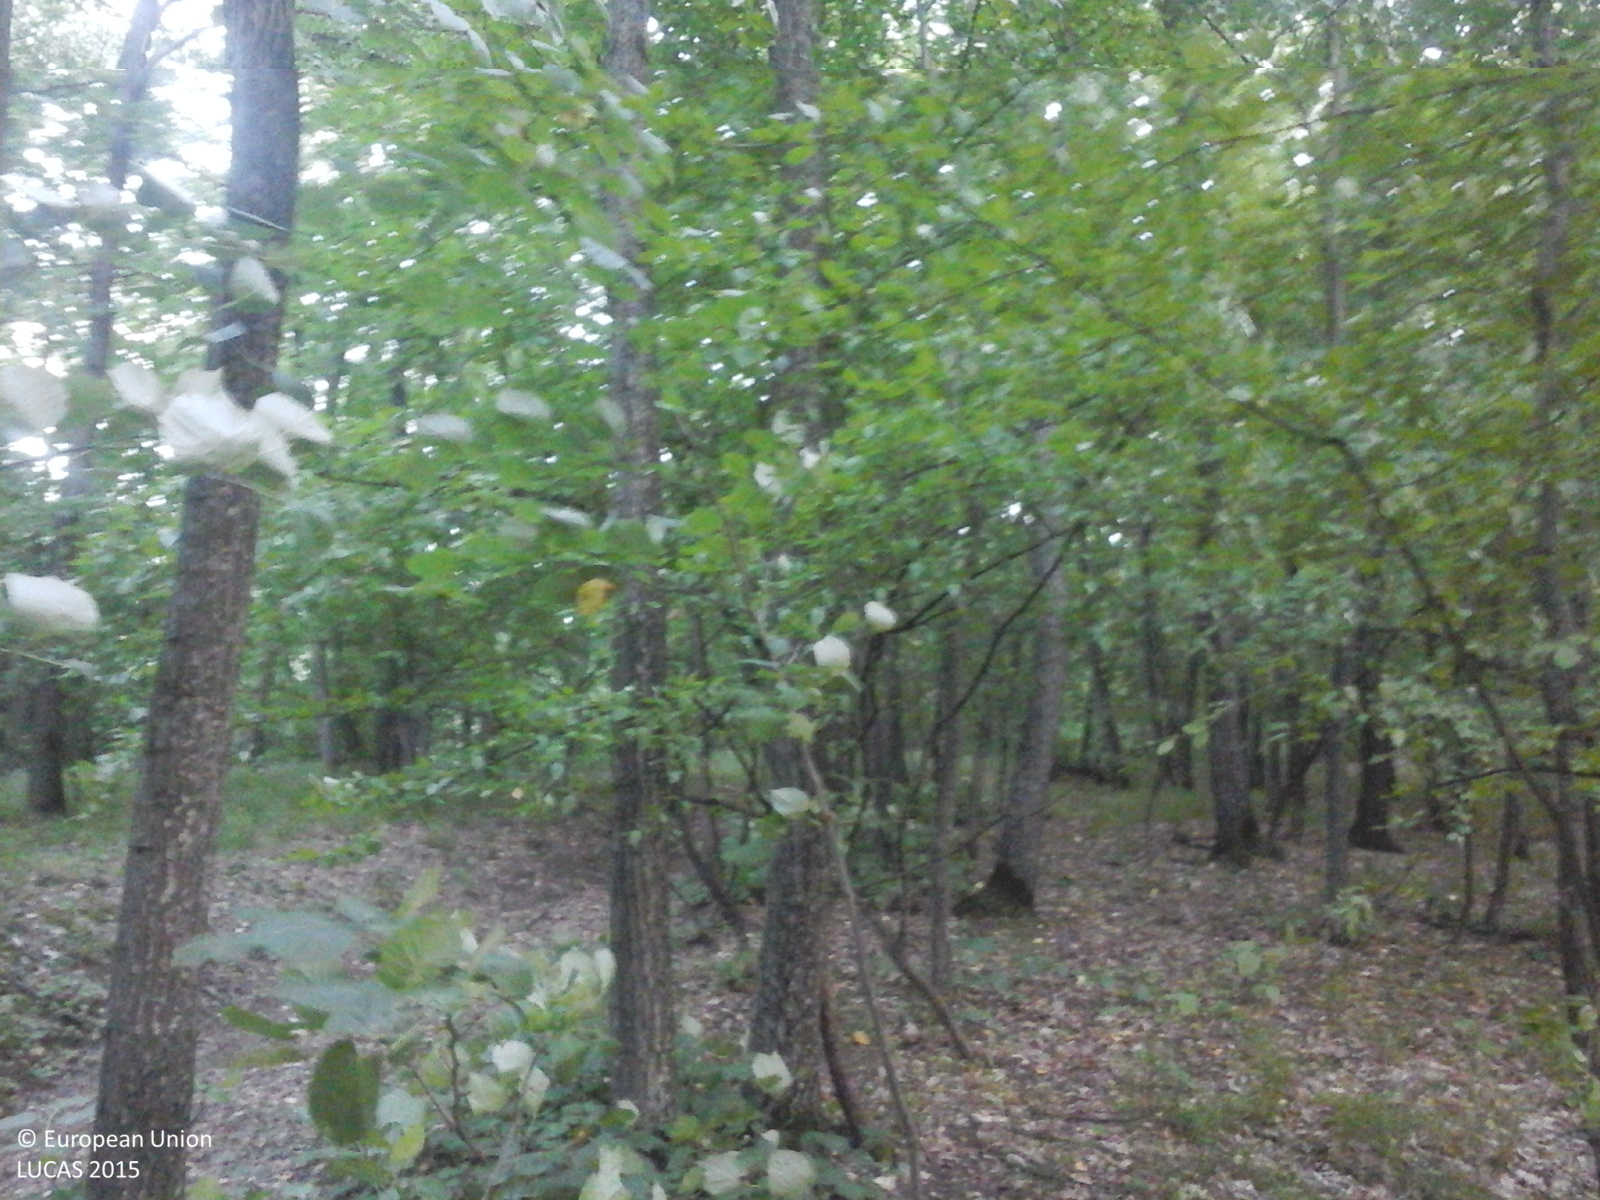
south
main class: Woodland
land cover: Broadleaved woodland
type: beech forest
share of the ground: > 75 %
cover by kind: broadleaved forest trees 100 %
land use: Forestry
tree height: > 5 m
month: June
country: RO
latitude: 47.1485
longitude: 26.9939
